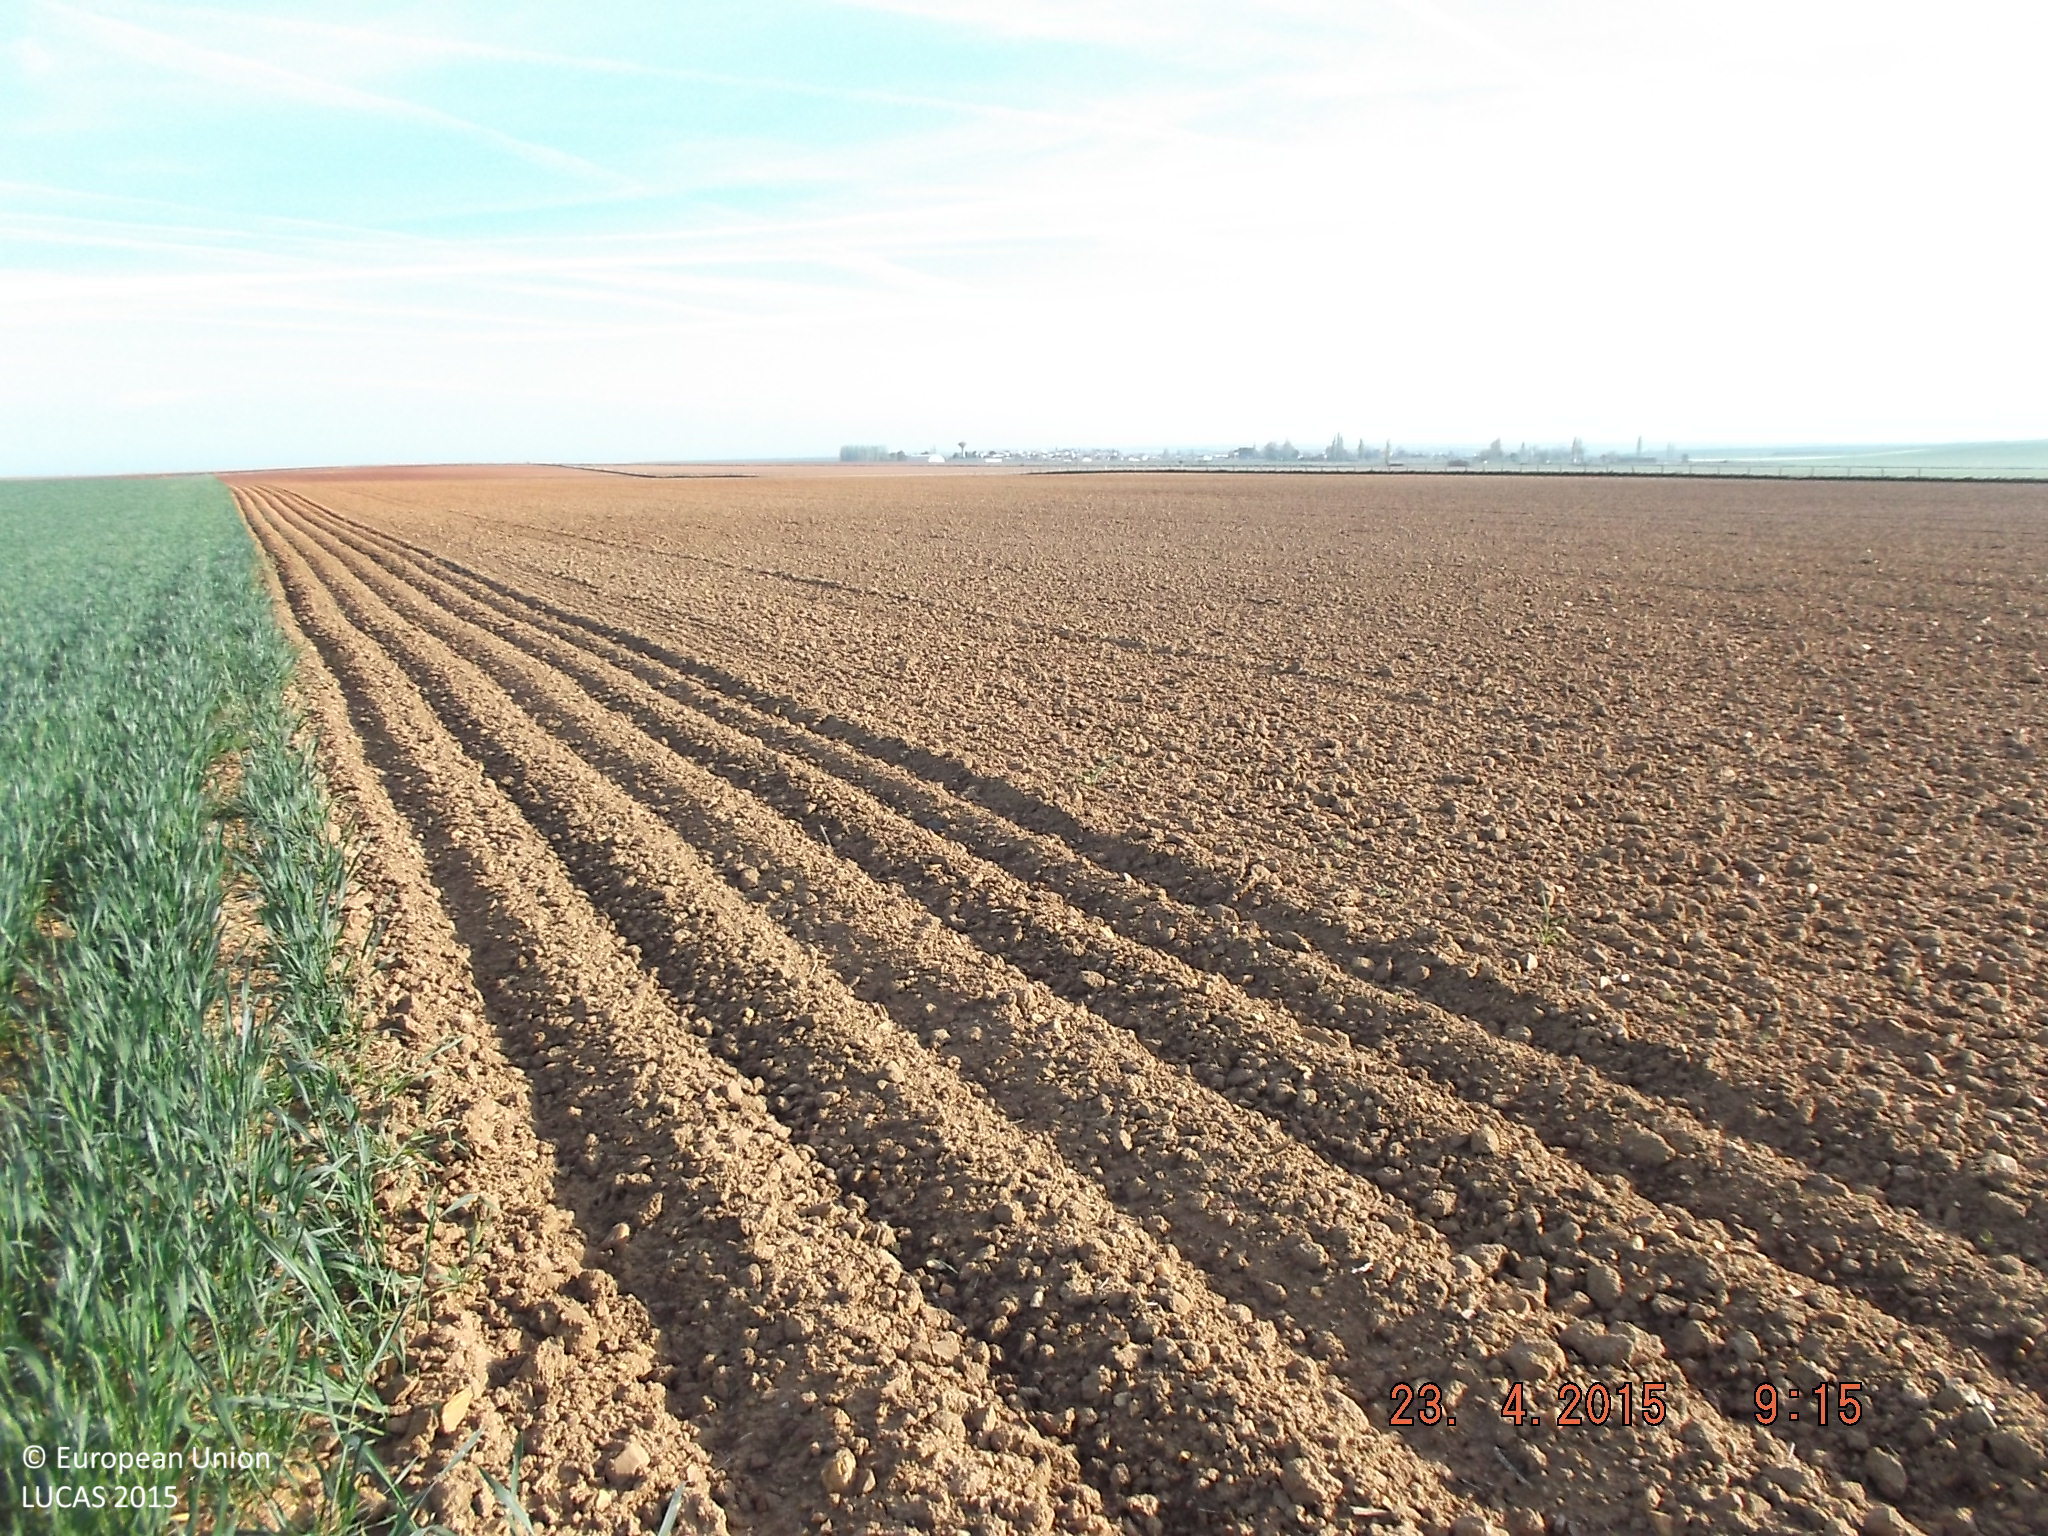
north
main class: Cropland
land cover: Common wheat
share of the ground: > 75 %
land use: Agriculture (excluding fallow land and kitchen gardens)
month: April
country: ES
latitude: 40.9135
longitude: -5.8838
